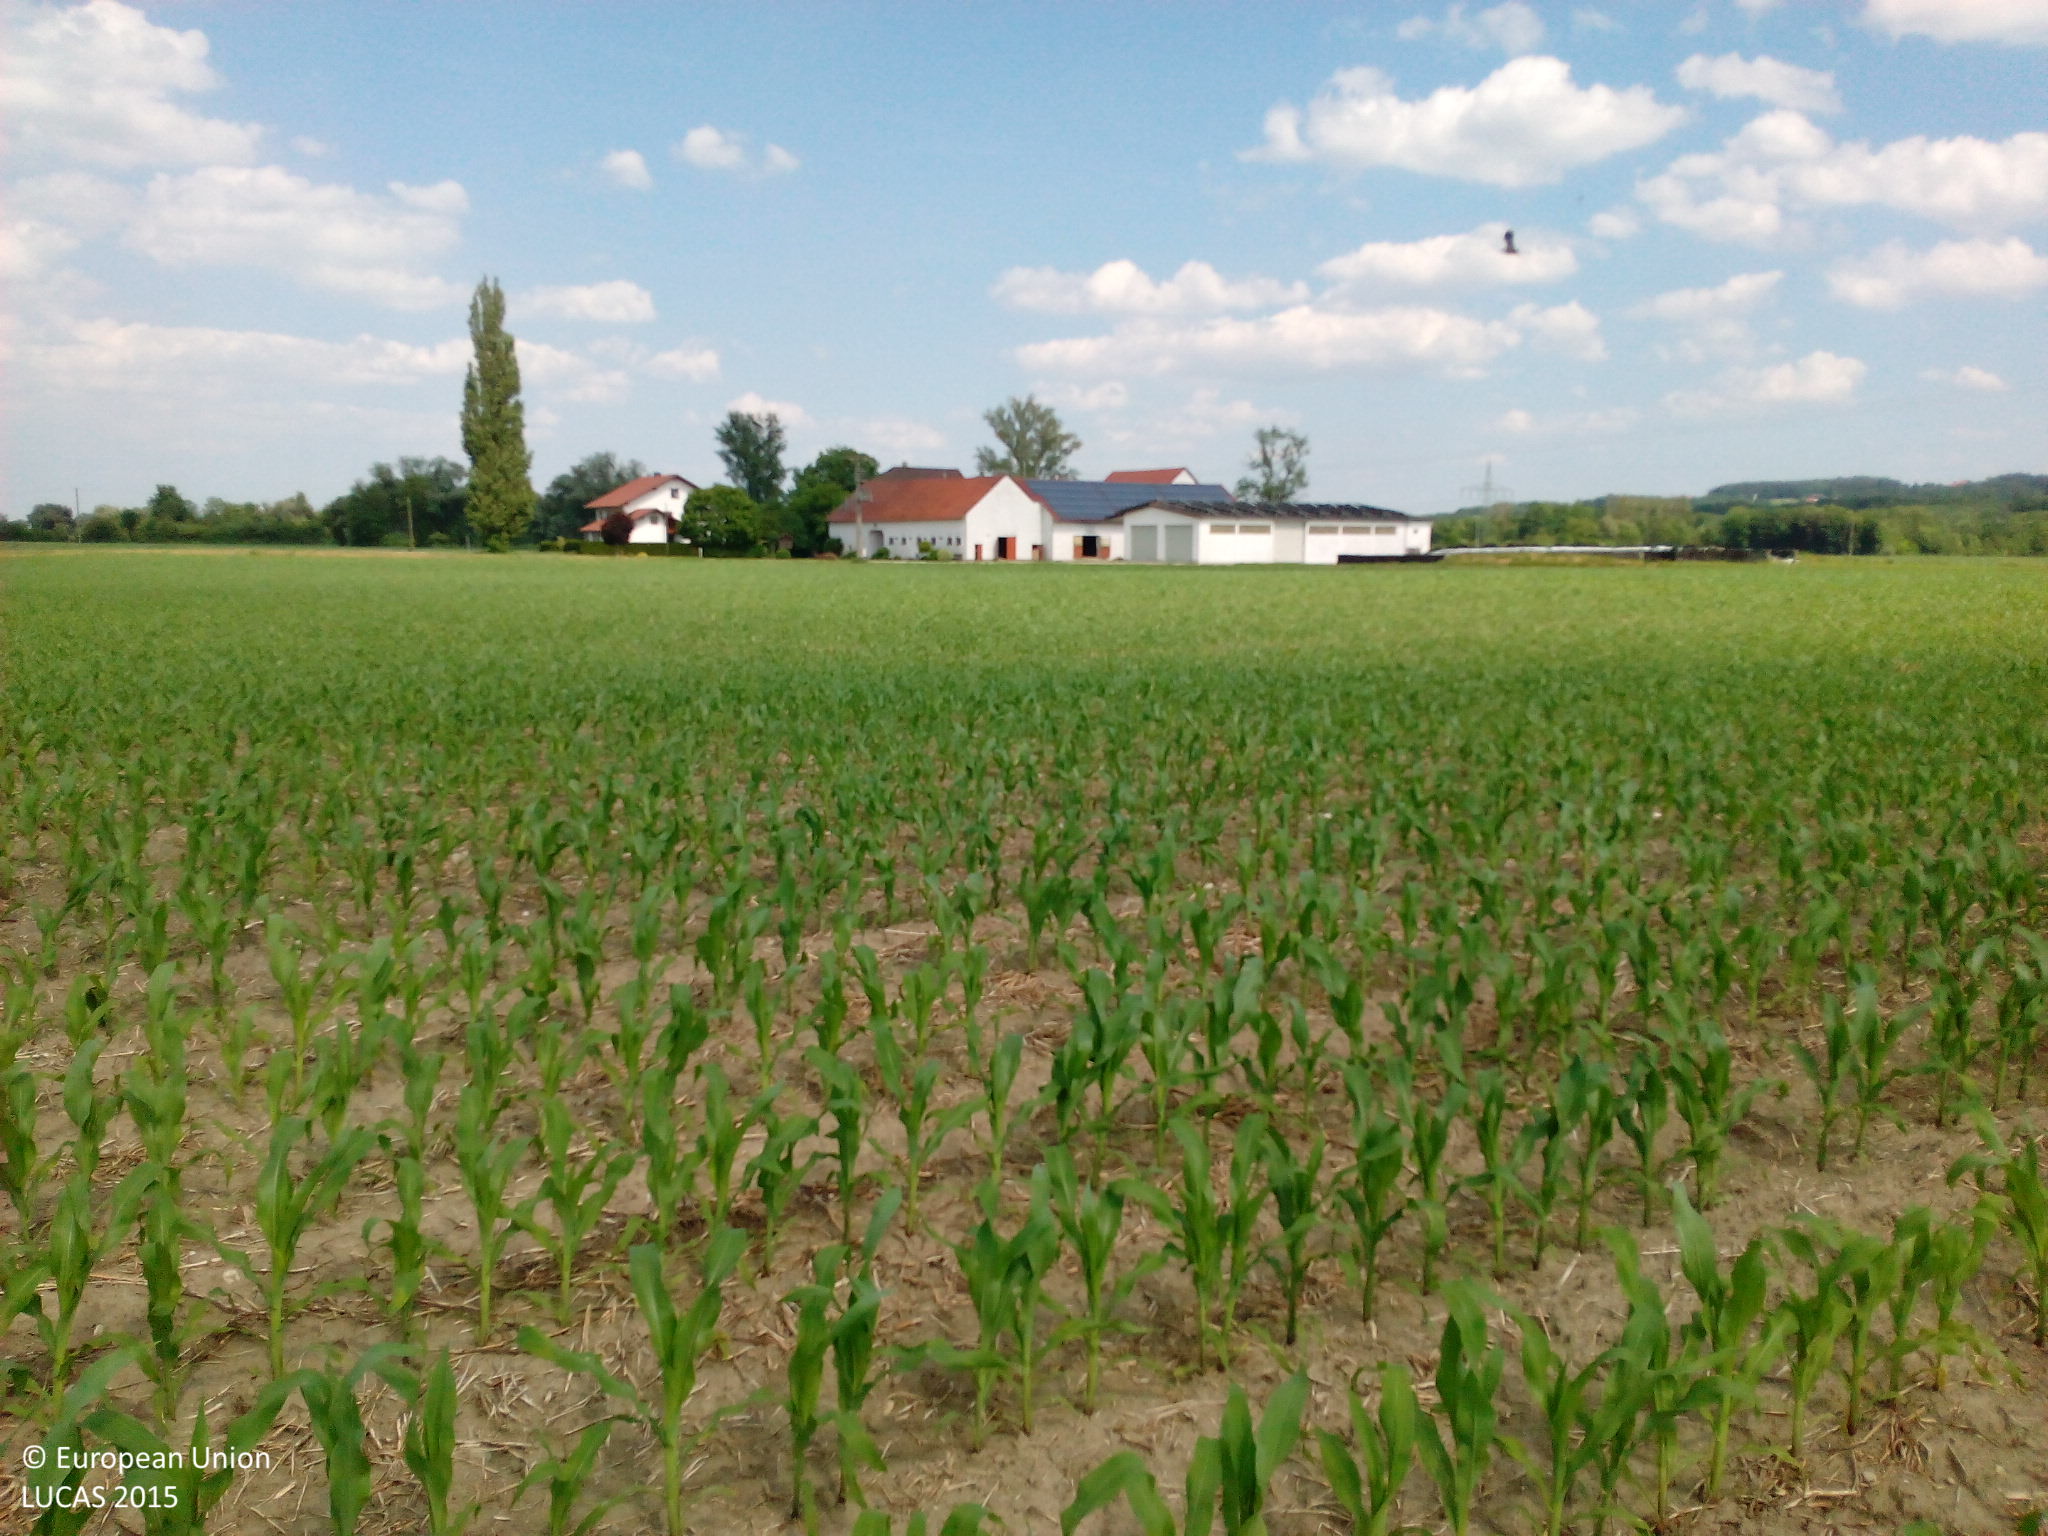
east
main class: Cropland
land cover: Maize
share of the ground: 25 - 50 %
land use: Agriculture (excluding fallow land and kitchen gardens)
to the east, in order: Maize; Electric lines; Maize; Grass margins; Artificial constructions in urban areas
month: June
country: DE
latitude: 48.6294
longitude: 12.4008
